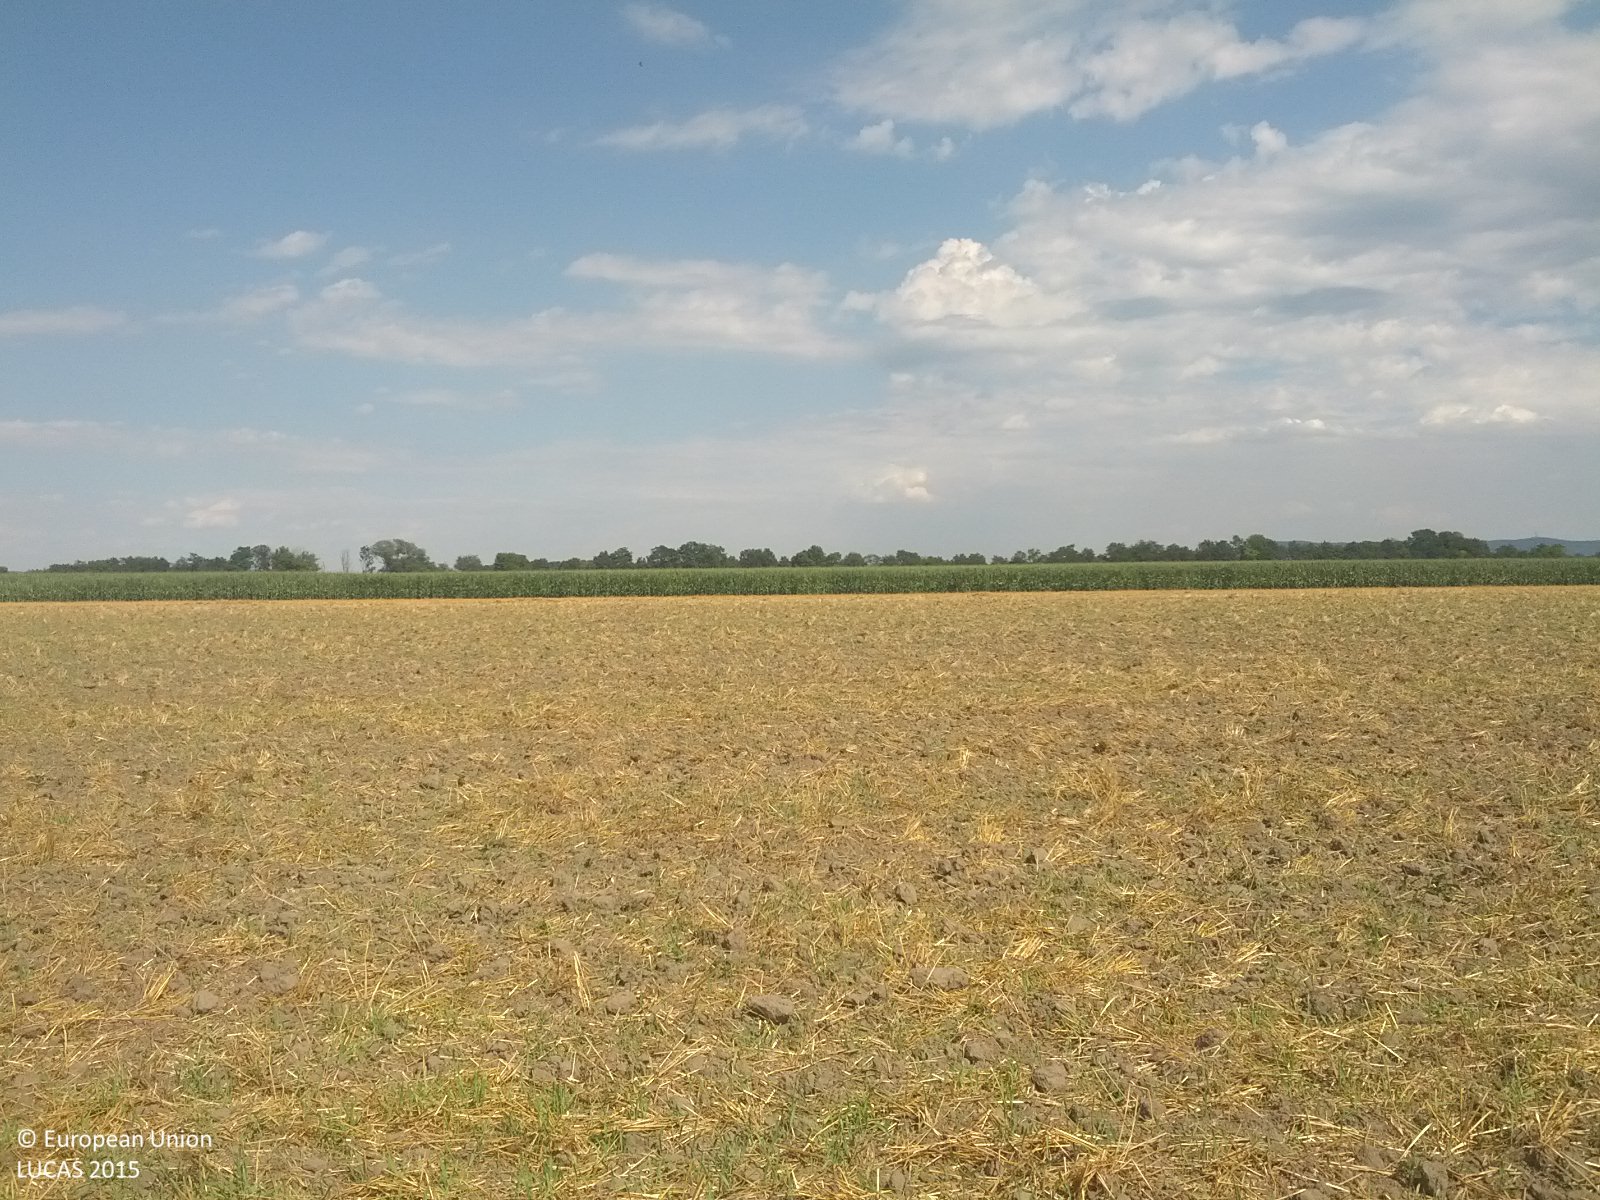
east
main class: Grassland
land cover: Spontaneously vegetated surfaces
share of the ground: < 10 %
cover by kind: unconsolidated bare surface 90 %, herbaceous plants 10 %
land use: Agriculture (excluding fallow land and kitchen gardens)
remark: Harvested field
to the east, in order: Spontaneously vegetated surfaces; Common wheat; Maize; Other bare soil
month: July
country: AT
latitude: 48.3798
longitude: 16.0937
